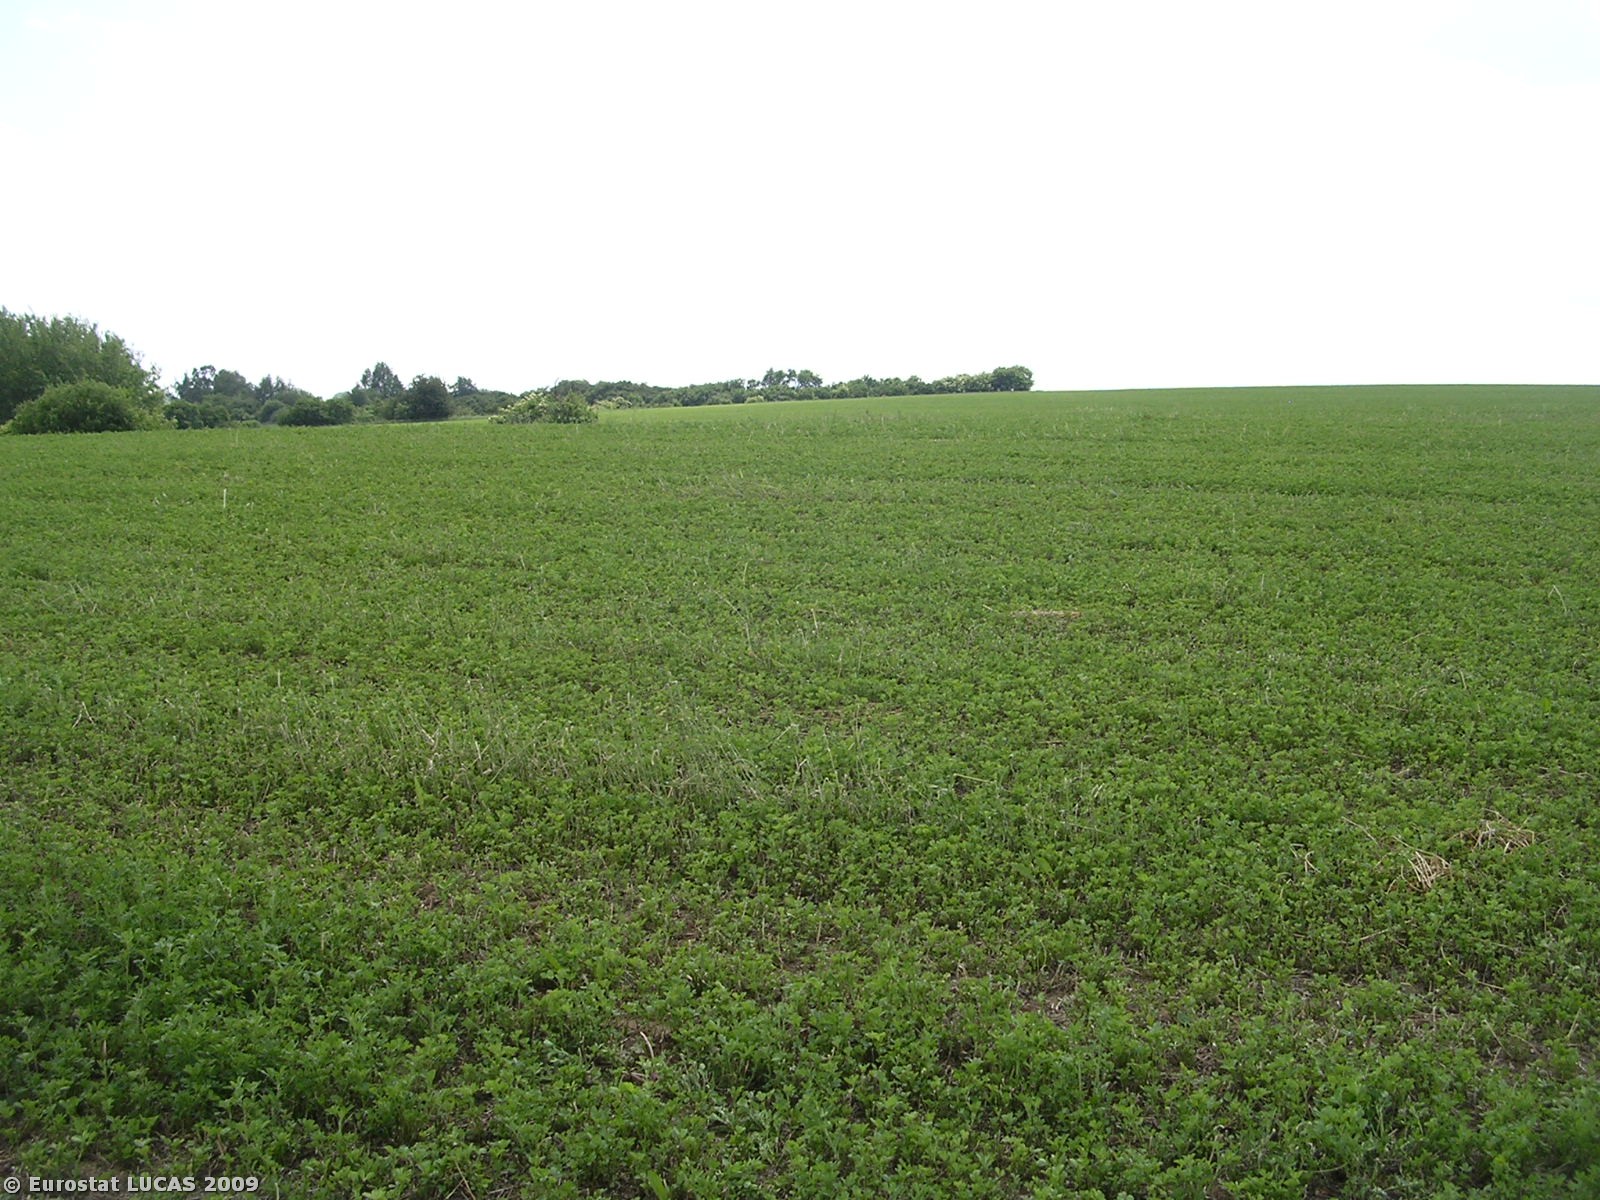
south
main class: Cropland
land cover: Lucerne
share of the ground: > 75 %
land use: Agriculture (excluding fallow land and kitchen gardens)
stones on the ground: < 10 %
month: May
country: CZ
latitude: 50.3212
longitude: 14.7073
